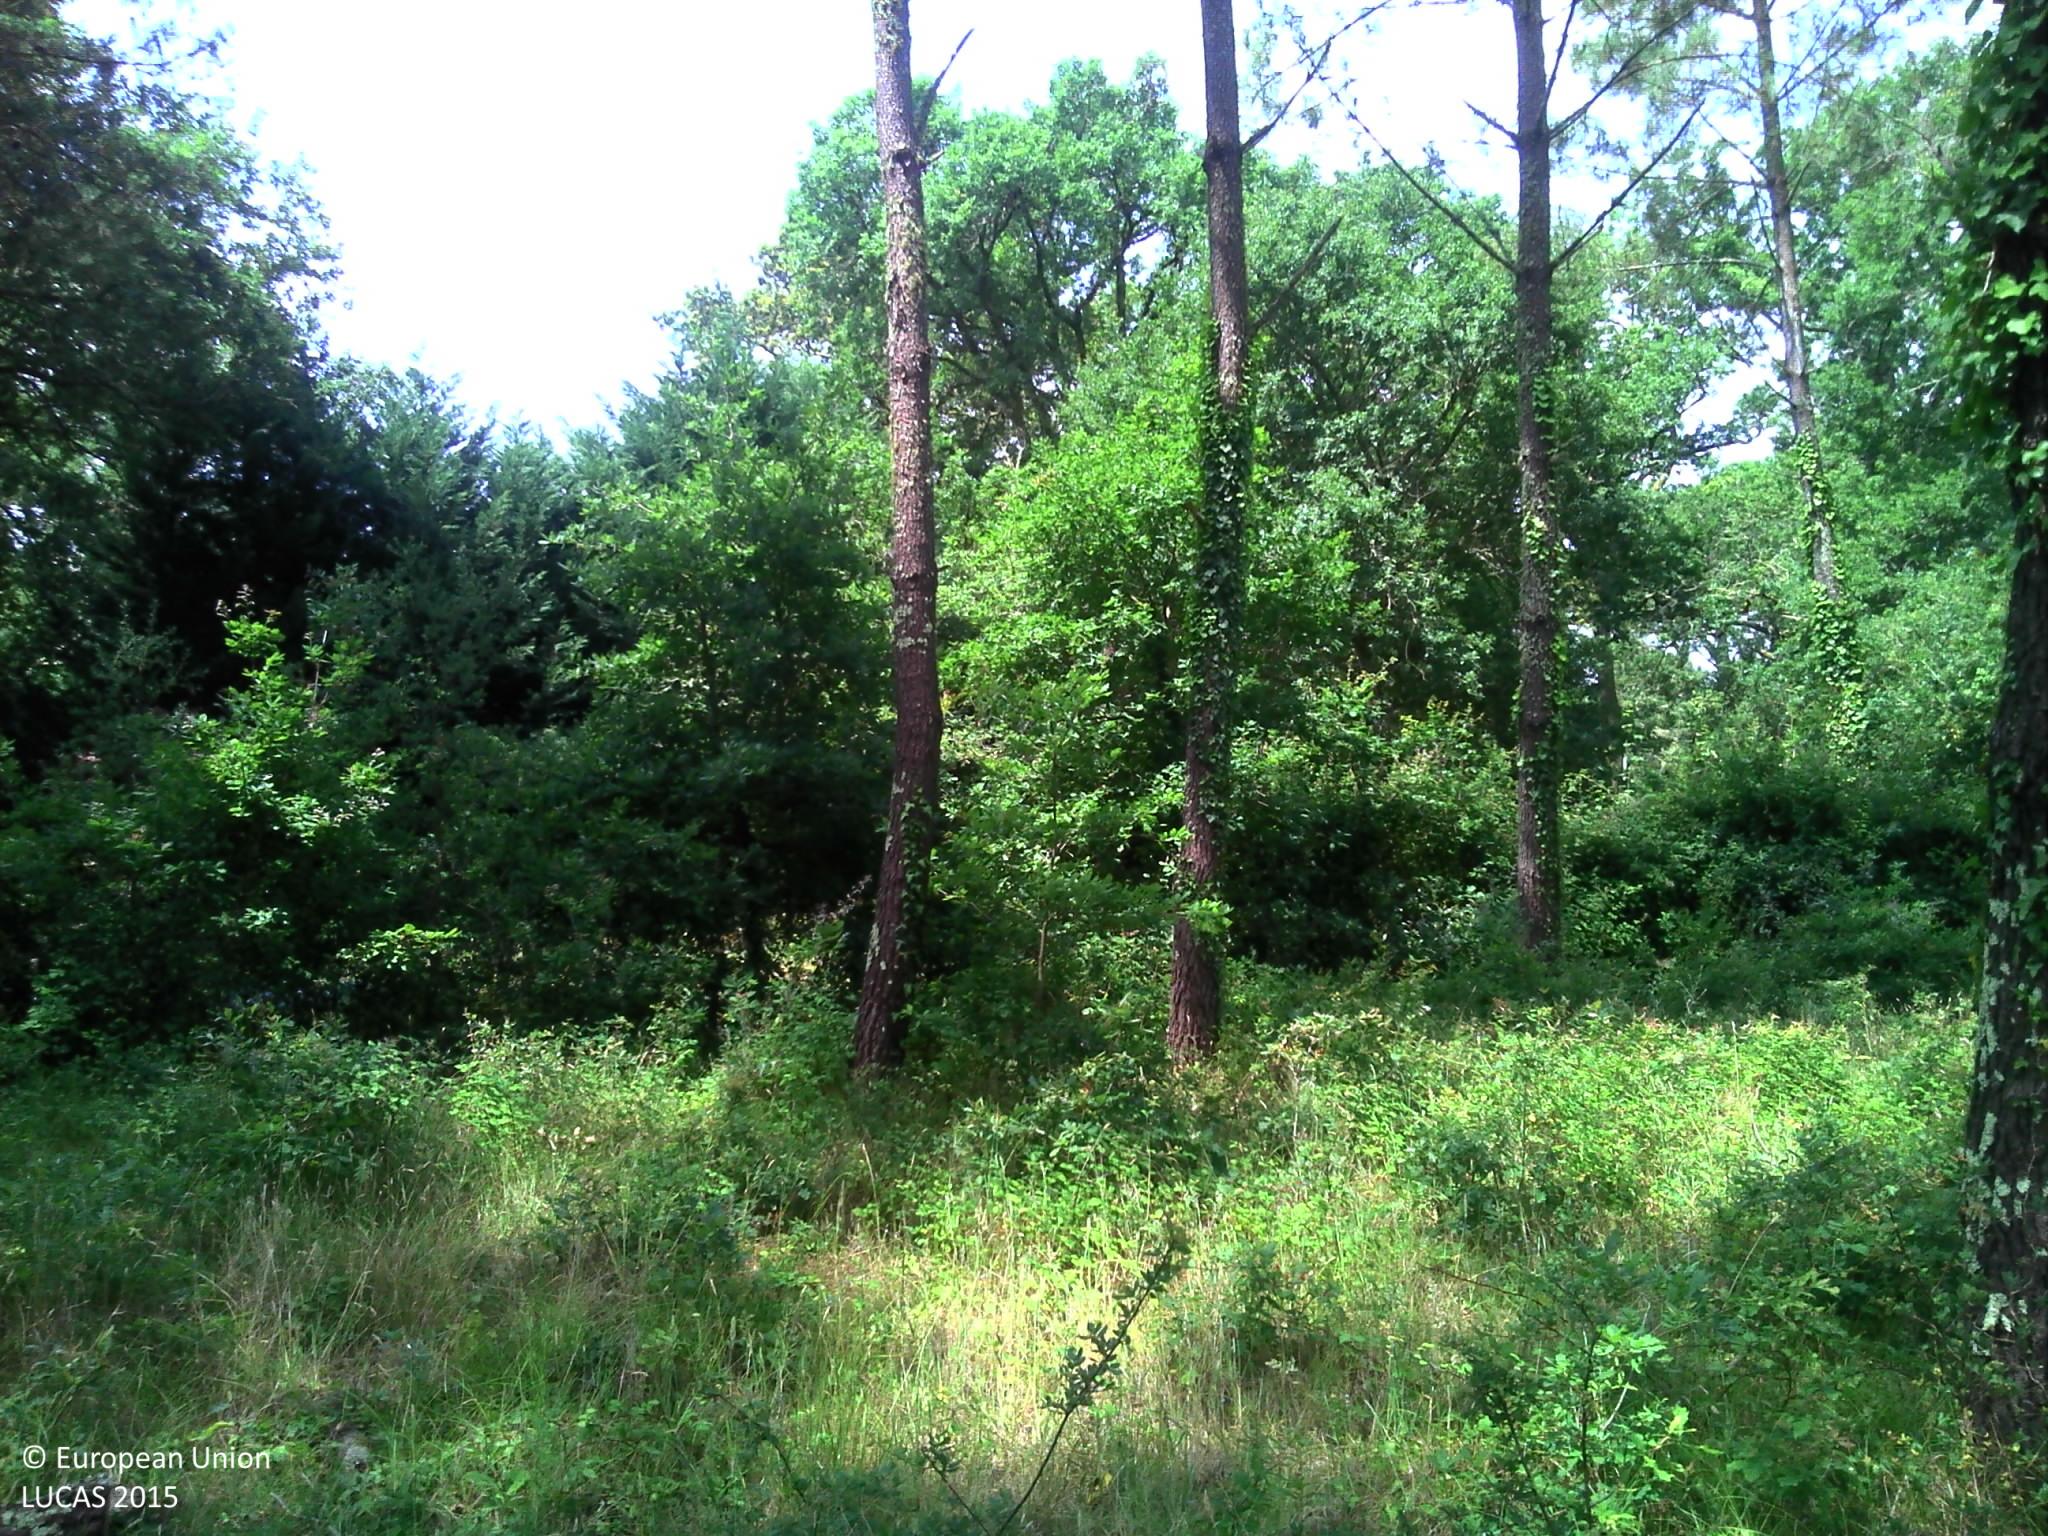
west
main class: Woodland
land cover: Pine dominated coniferous woodland
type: coniferous forest of the mediterranean region
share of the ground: > 75 %
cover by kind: coniferous forest trees 90 %, broadleaved forest trees 5 %, herbaceous plants 5 %
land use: Forestry
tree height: > 5 m
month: July
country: FR
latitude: 43.8048
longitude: -1.2929
